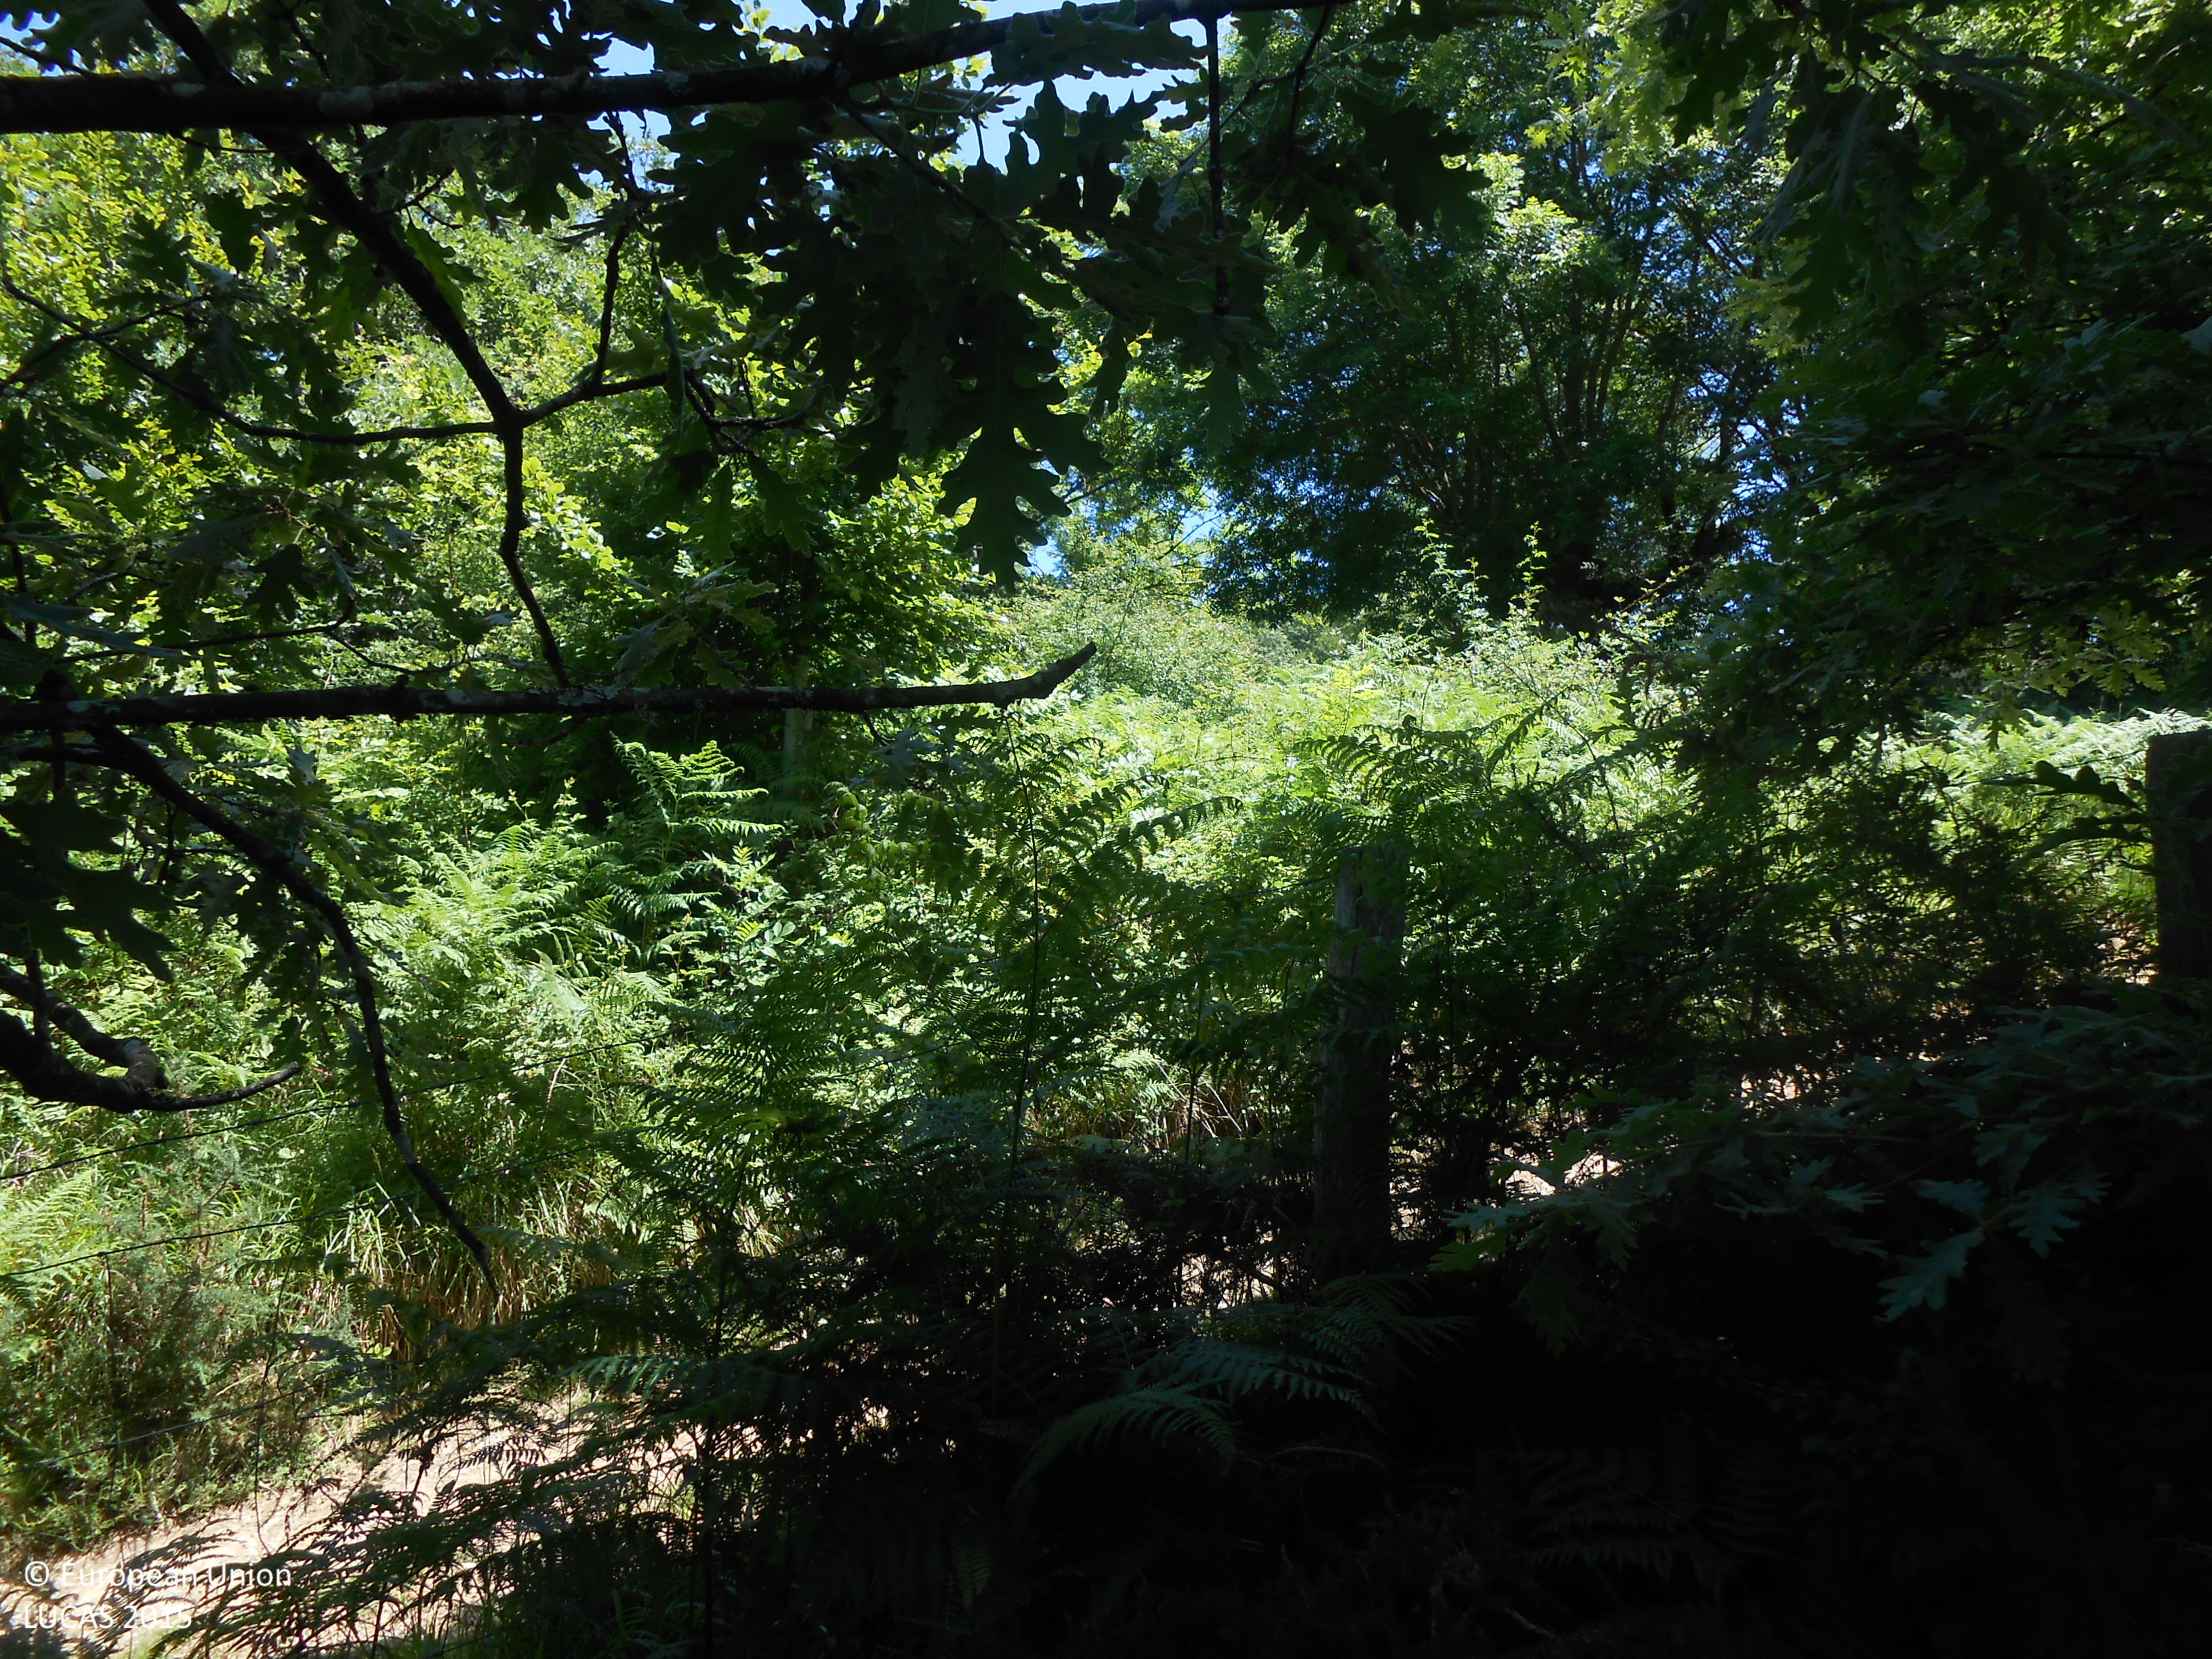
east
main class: Woodland
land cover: Broadleaved woodland
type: acidophilous oak and oak-birch forest
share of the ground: > 75 %
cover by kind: broadleaved forest trees 100 %
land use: Forestry
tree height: > 5 m
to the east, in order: Broadleaved woodland; Fences; Tracks; Broadleaved woodland; Grassland without tree/shrub cover; Broadleaved woodland
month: June
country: ES
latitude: 43.0112
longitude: -1.7093
